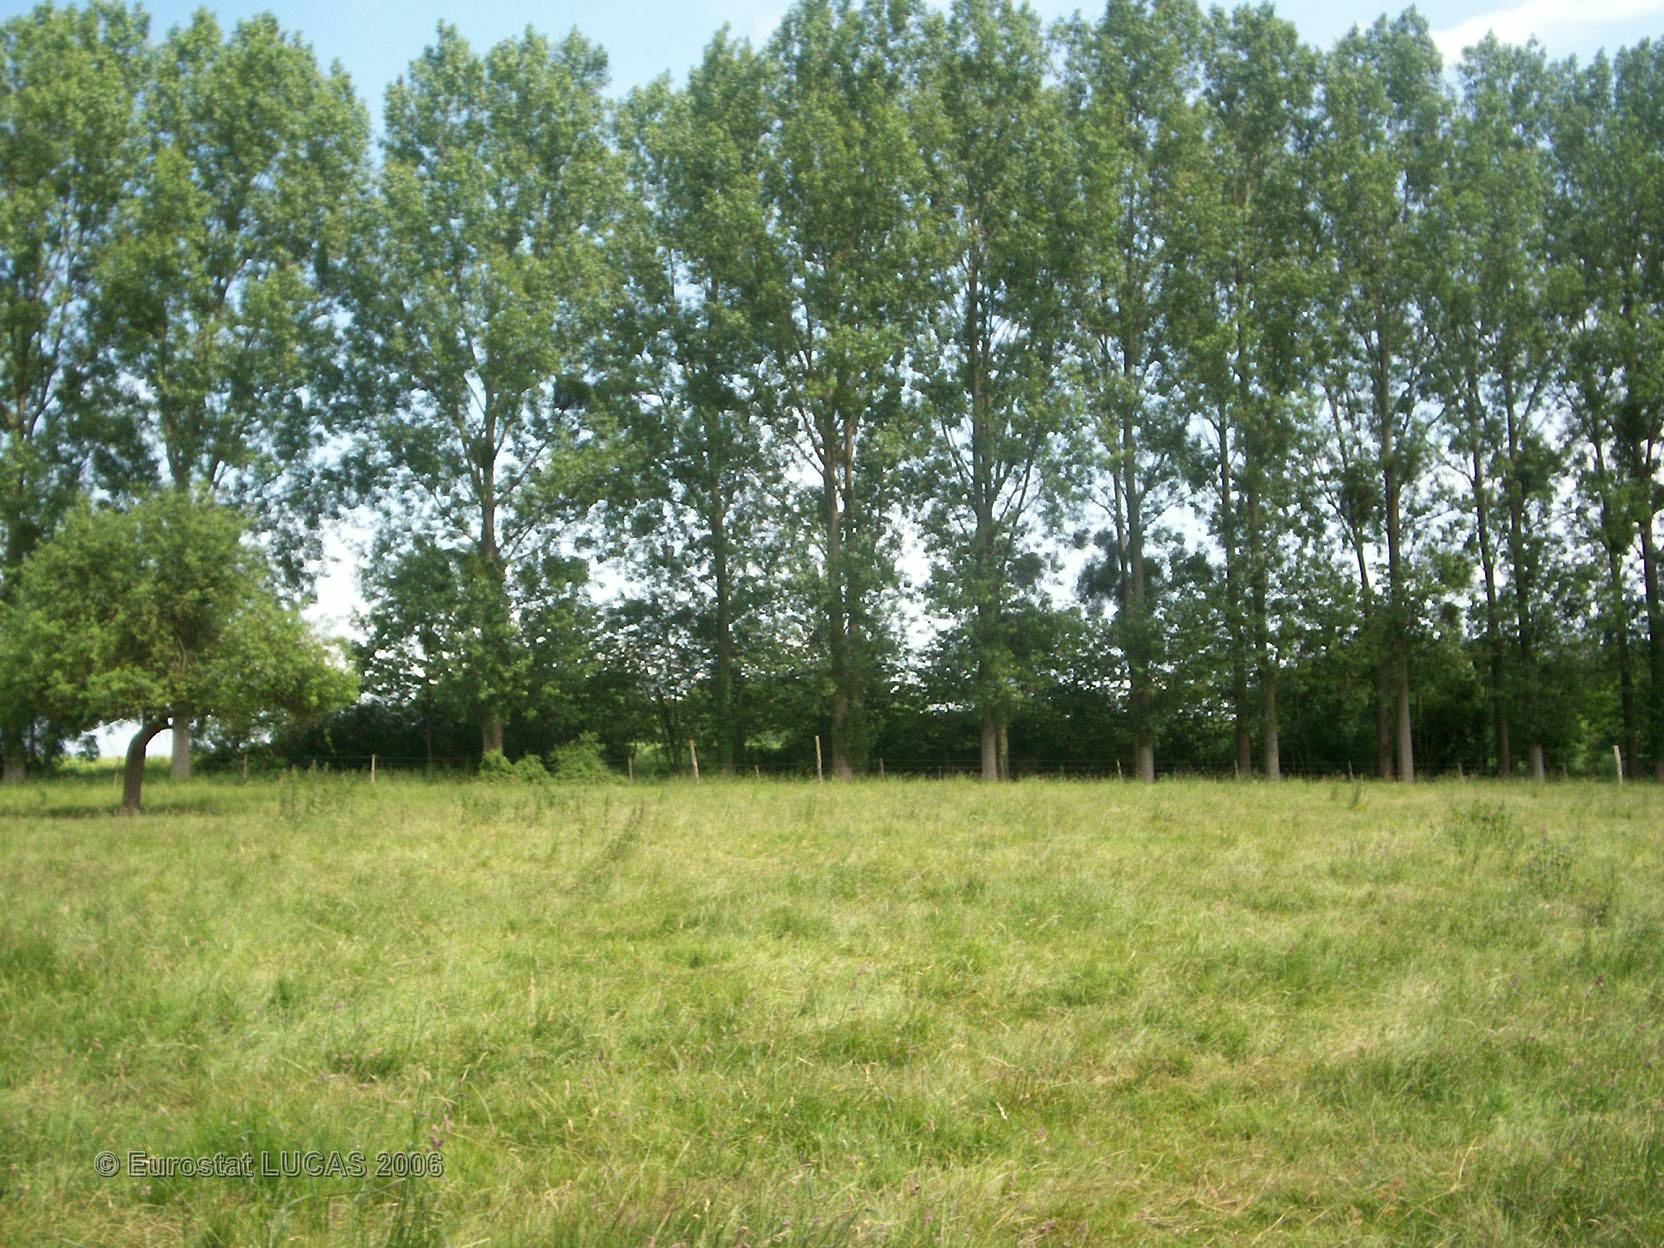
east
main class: Grassland
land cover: Grassland with sparse tree/shrub cover
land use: Agriculture (excluding fallow land and kitchen gardens)
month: June
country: FR
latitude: 49.4065
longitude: 2.6709
